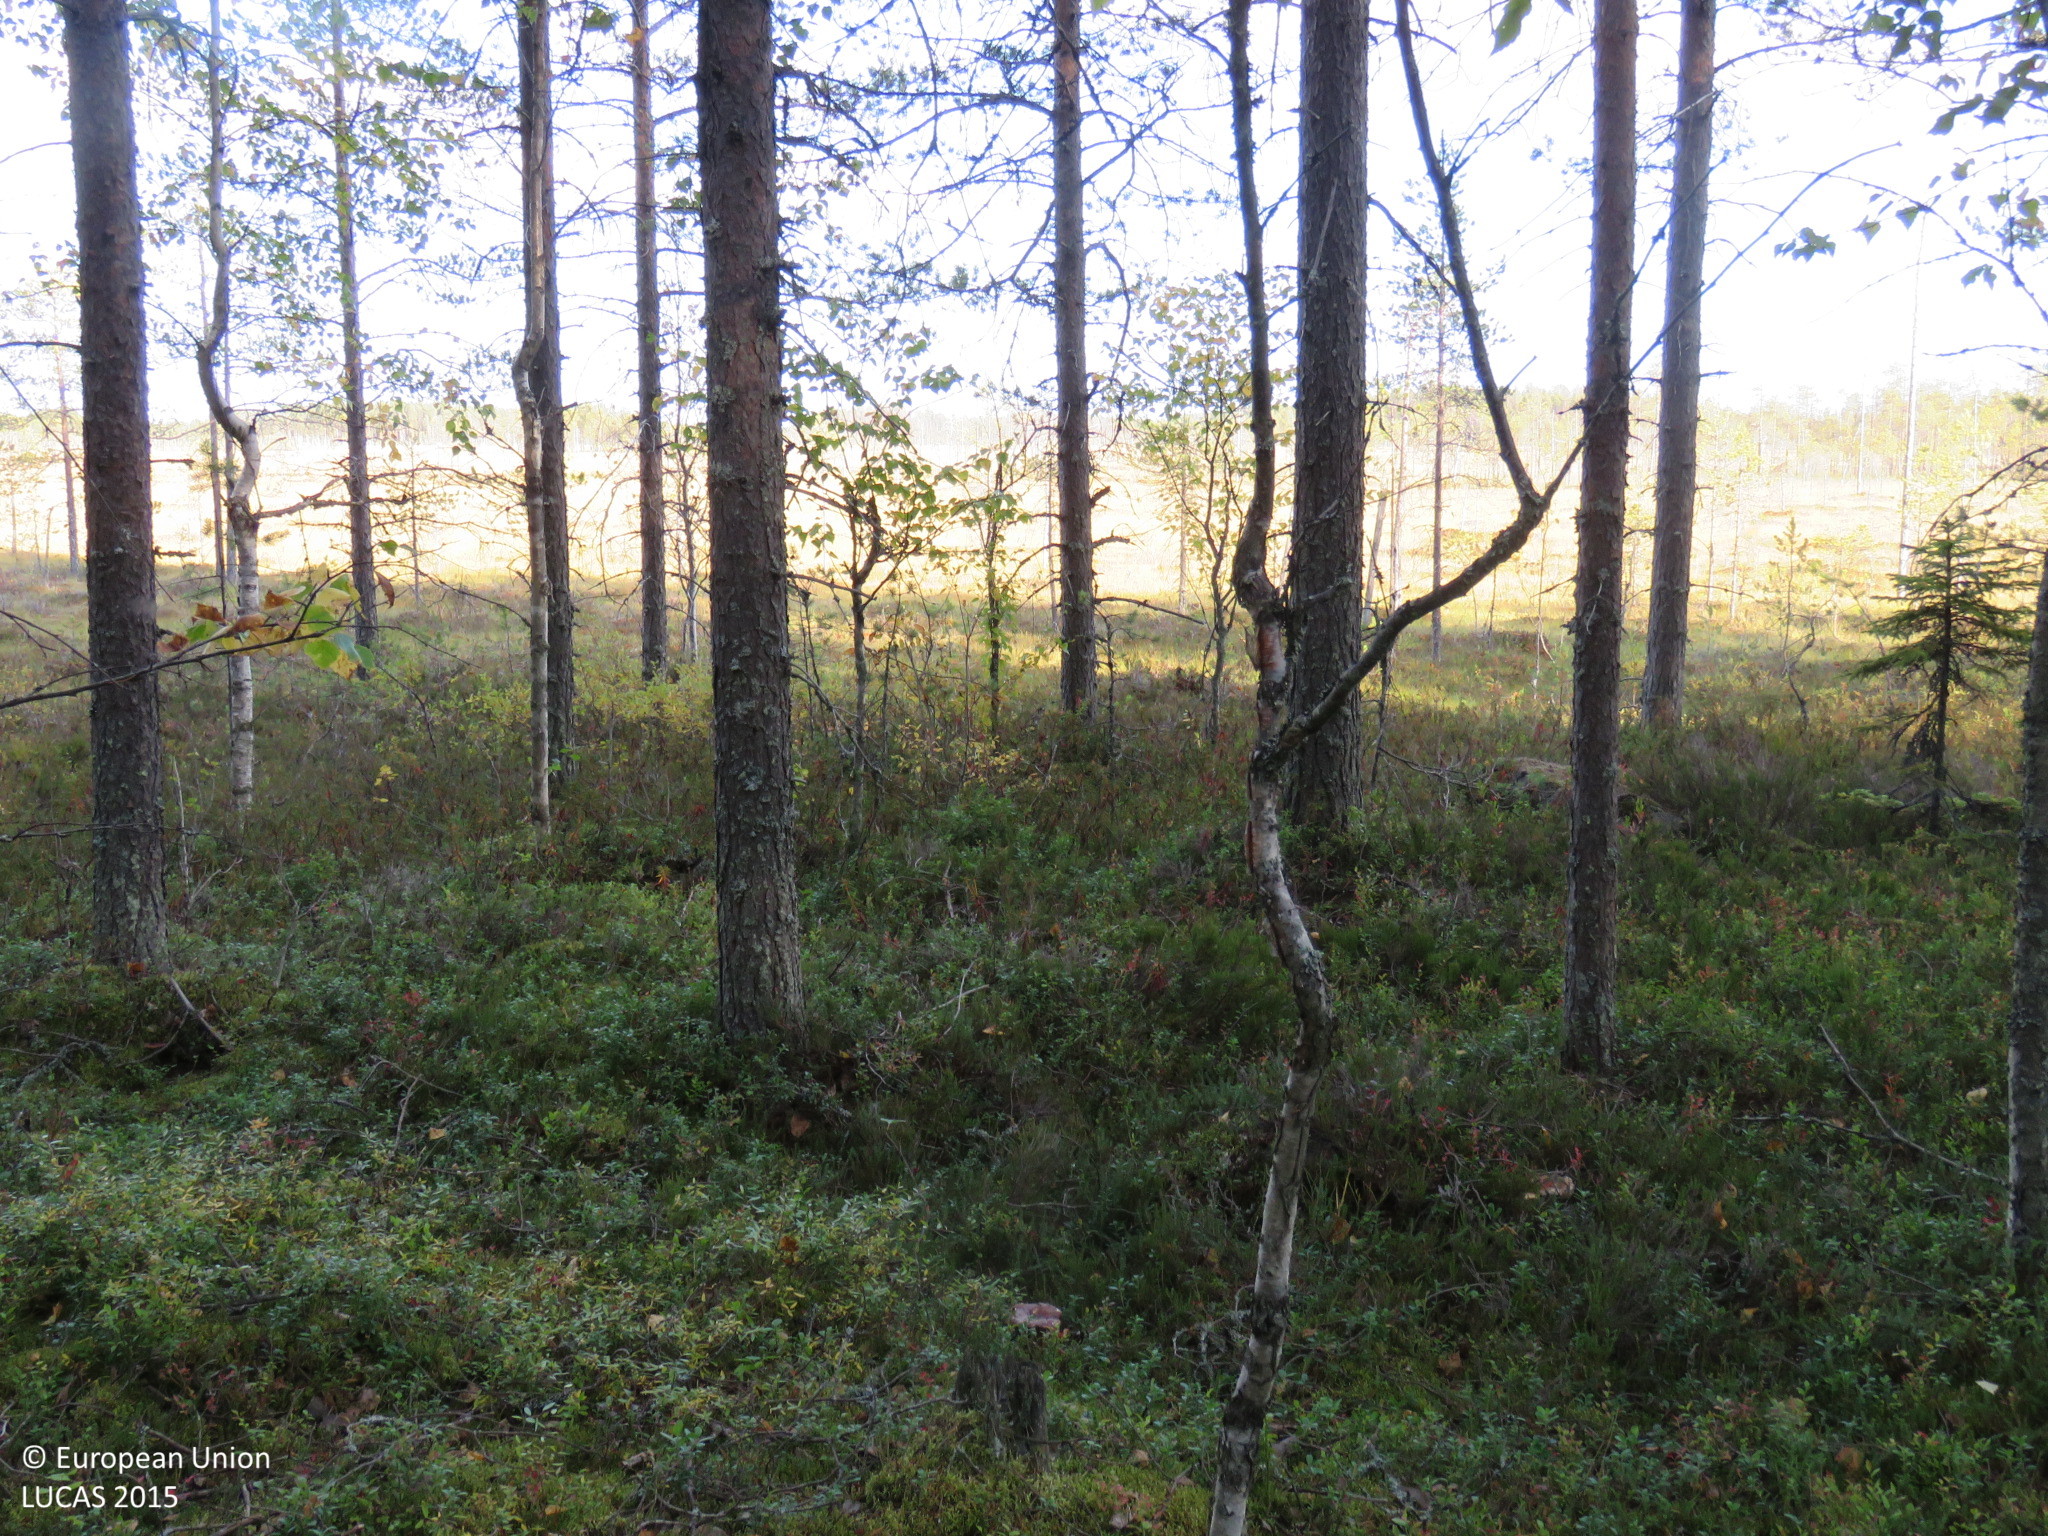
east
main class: Woodland
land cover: Pine dominated coniferous woodland
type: boreal forest
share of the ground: > 75 %
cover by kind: coniferous forest trees 60 %, shrubs 20 %, broadleaved forest trees 15 %, lichens and mosses 5 %
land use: Forestry
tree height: > 5 m
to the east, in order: Pine dominated coniferous woodland; Peatbogs; Pine dominated coniferous woodland; Peatbogs
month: September
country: FI
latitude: 65.0440
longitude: 26.7026
